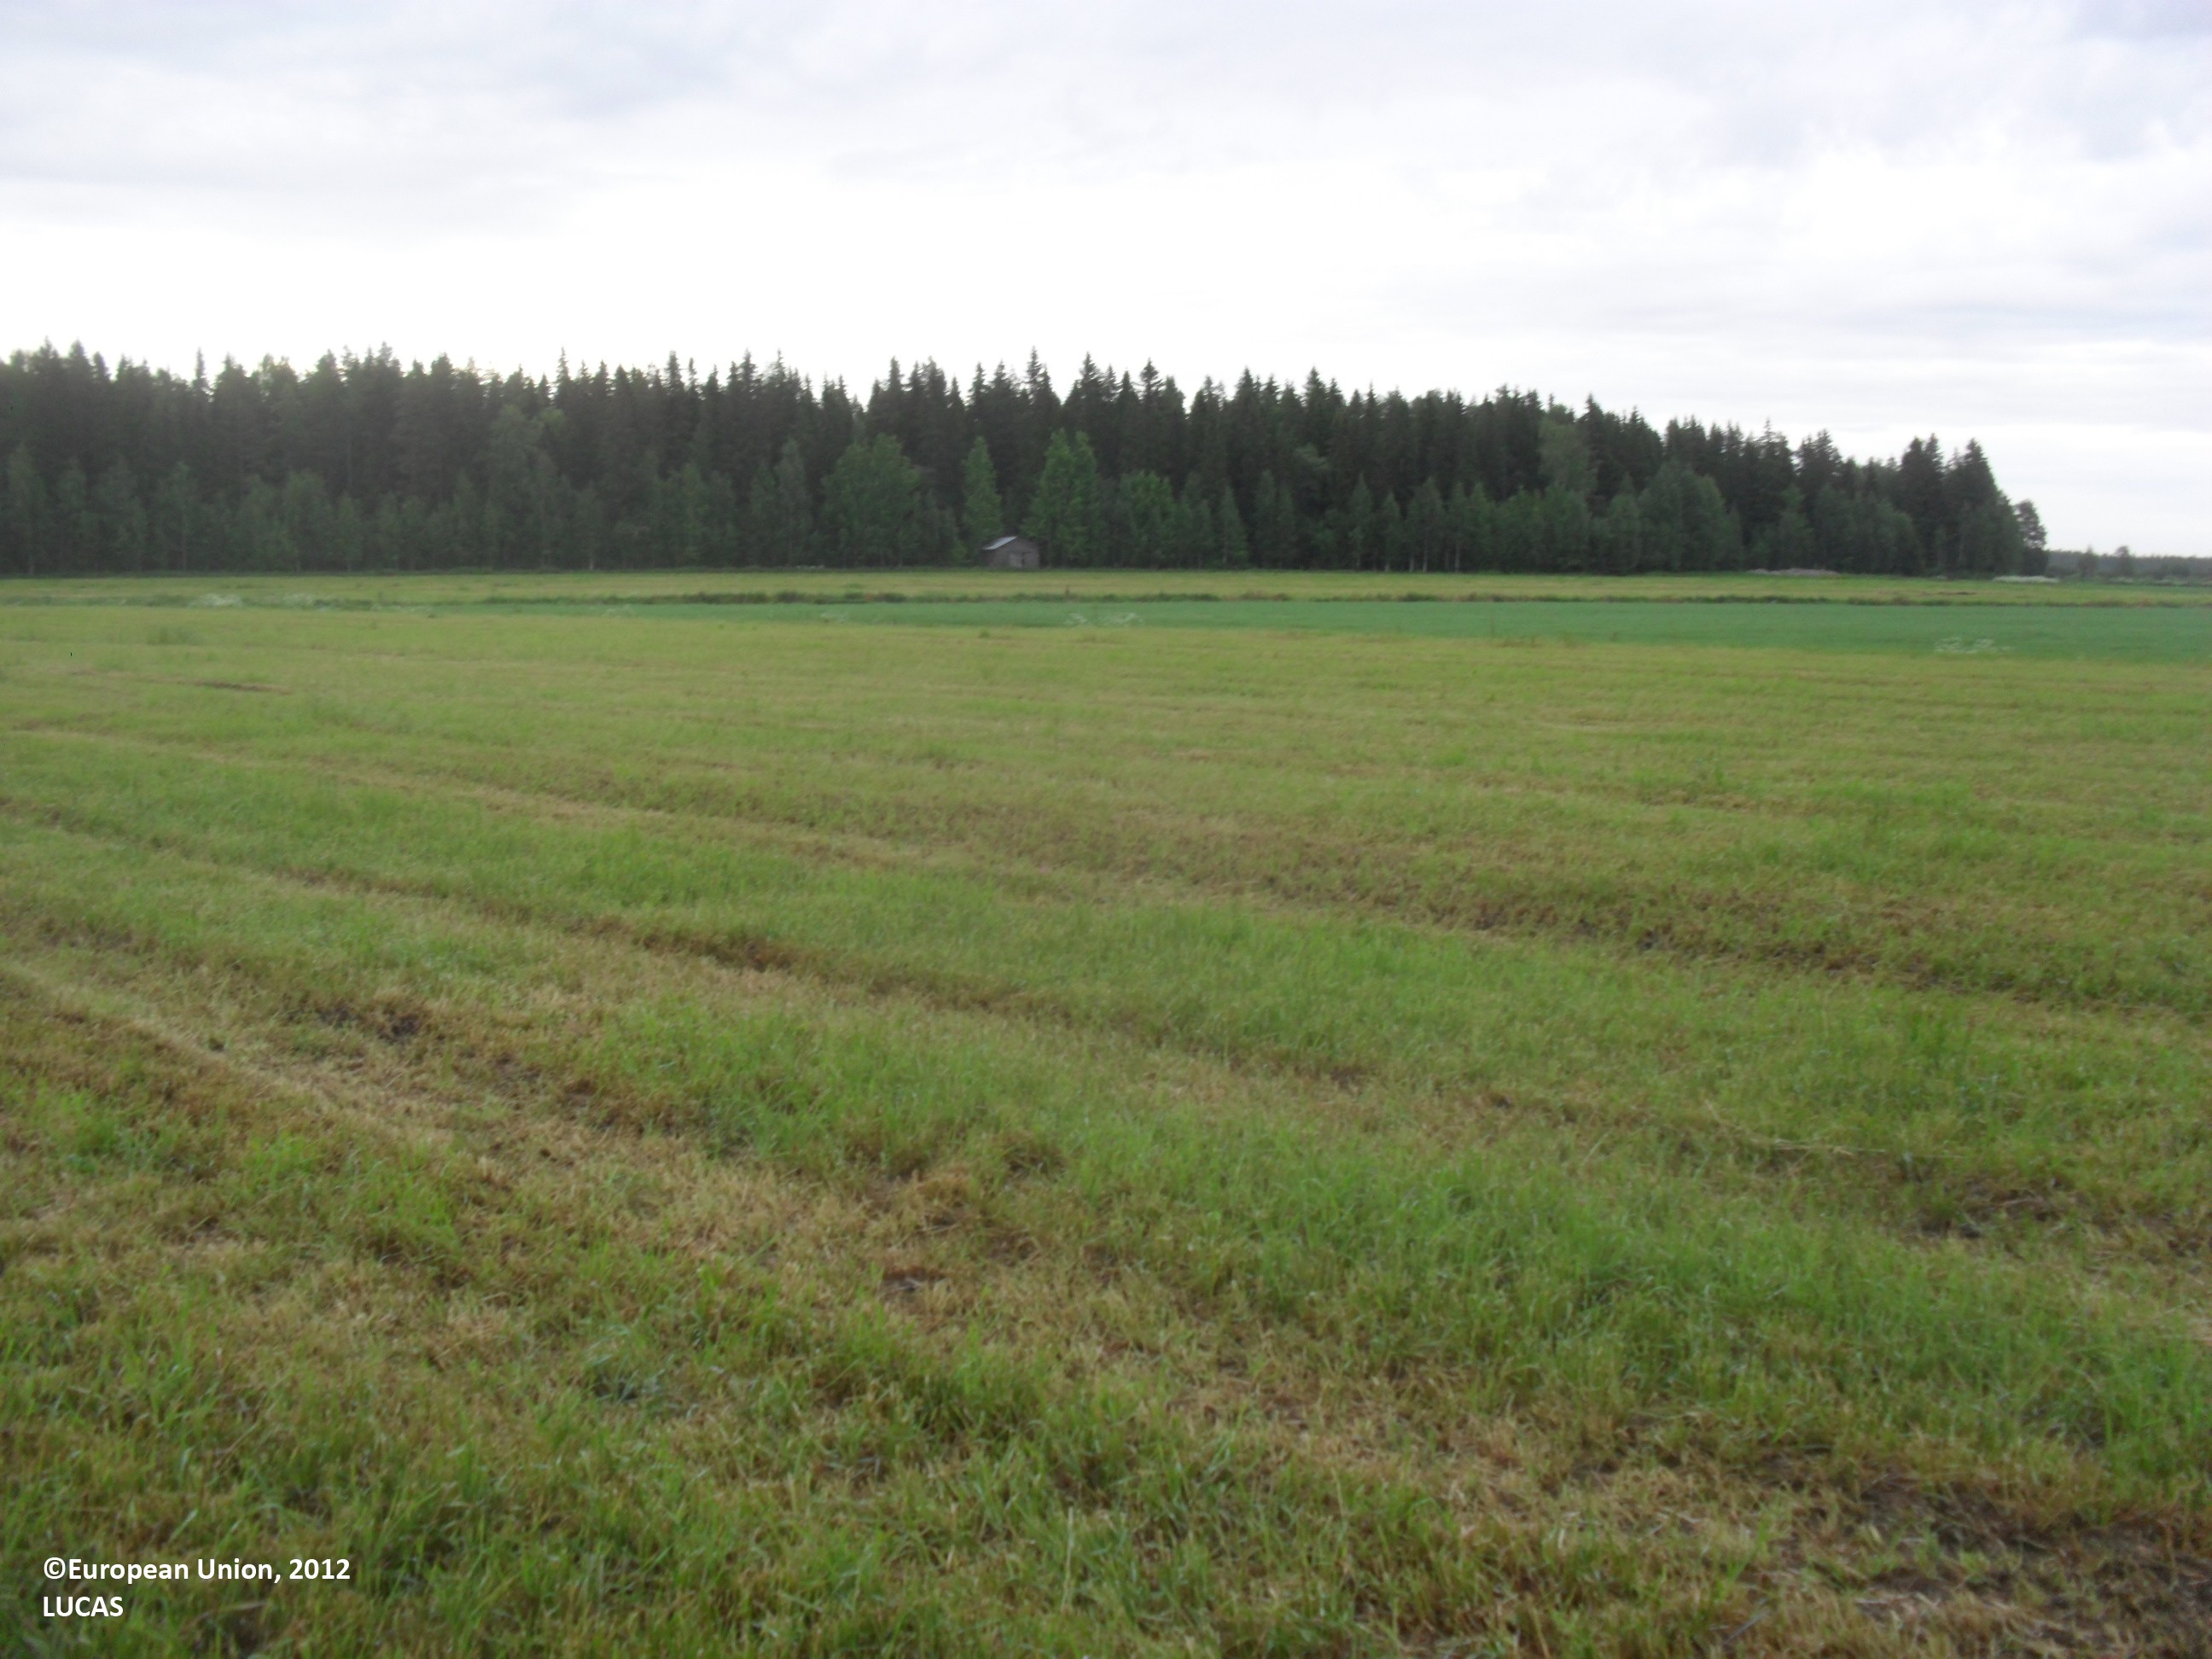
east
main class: Cropland
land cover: Temporary grasslands
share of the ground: > 75 %
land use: Agriculture (excluding fallow land and kitchen gardens)
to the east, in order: Temporary grasslands; Spontaneously vegetated surfaces; Ditches and canals; Grass margins; Barley; Spontaneously vegetated surfaces; Ditches and canals; Temporary grasslands
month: June
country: FI
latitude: 63.3460
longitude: 23.2261
